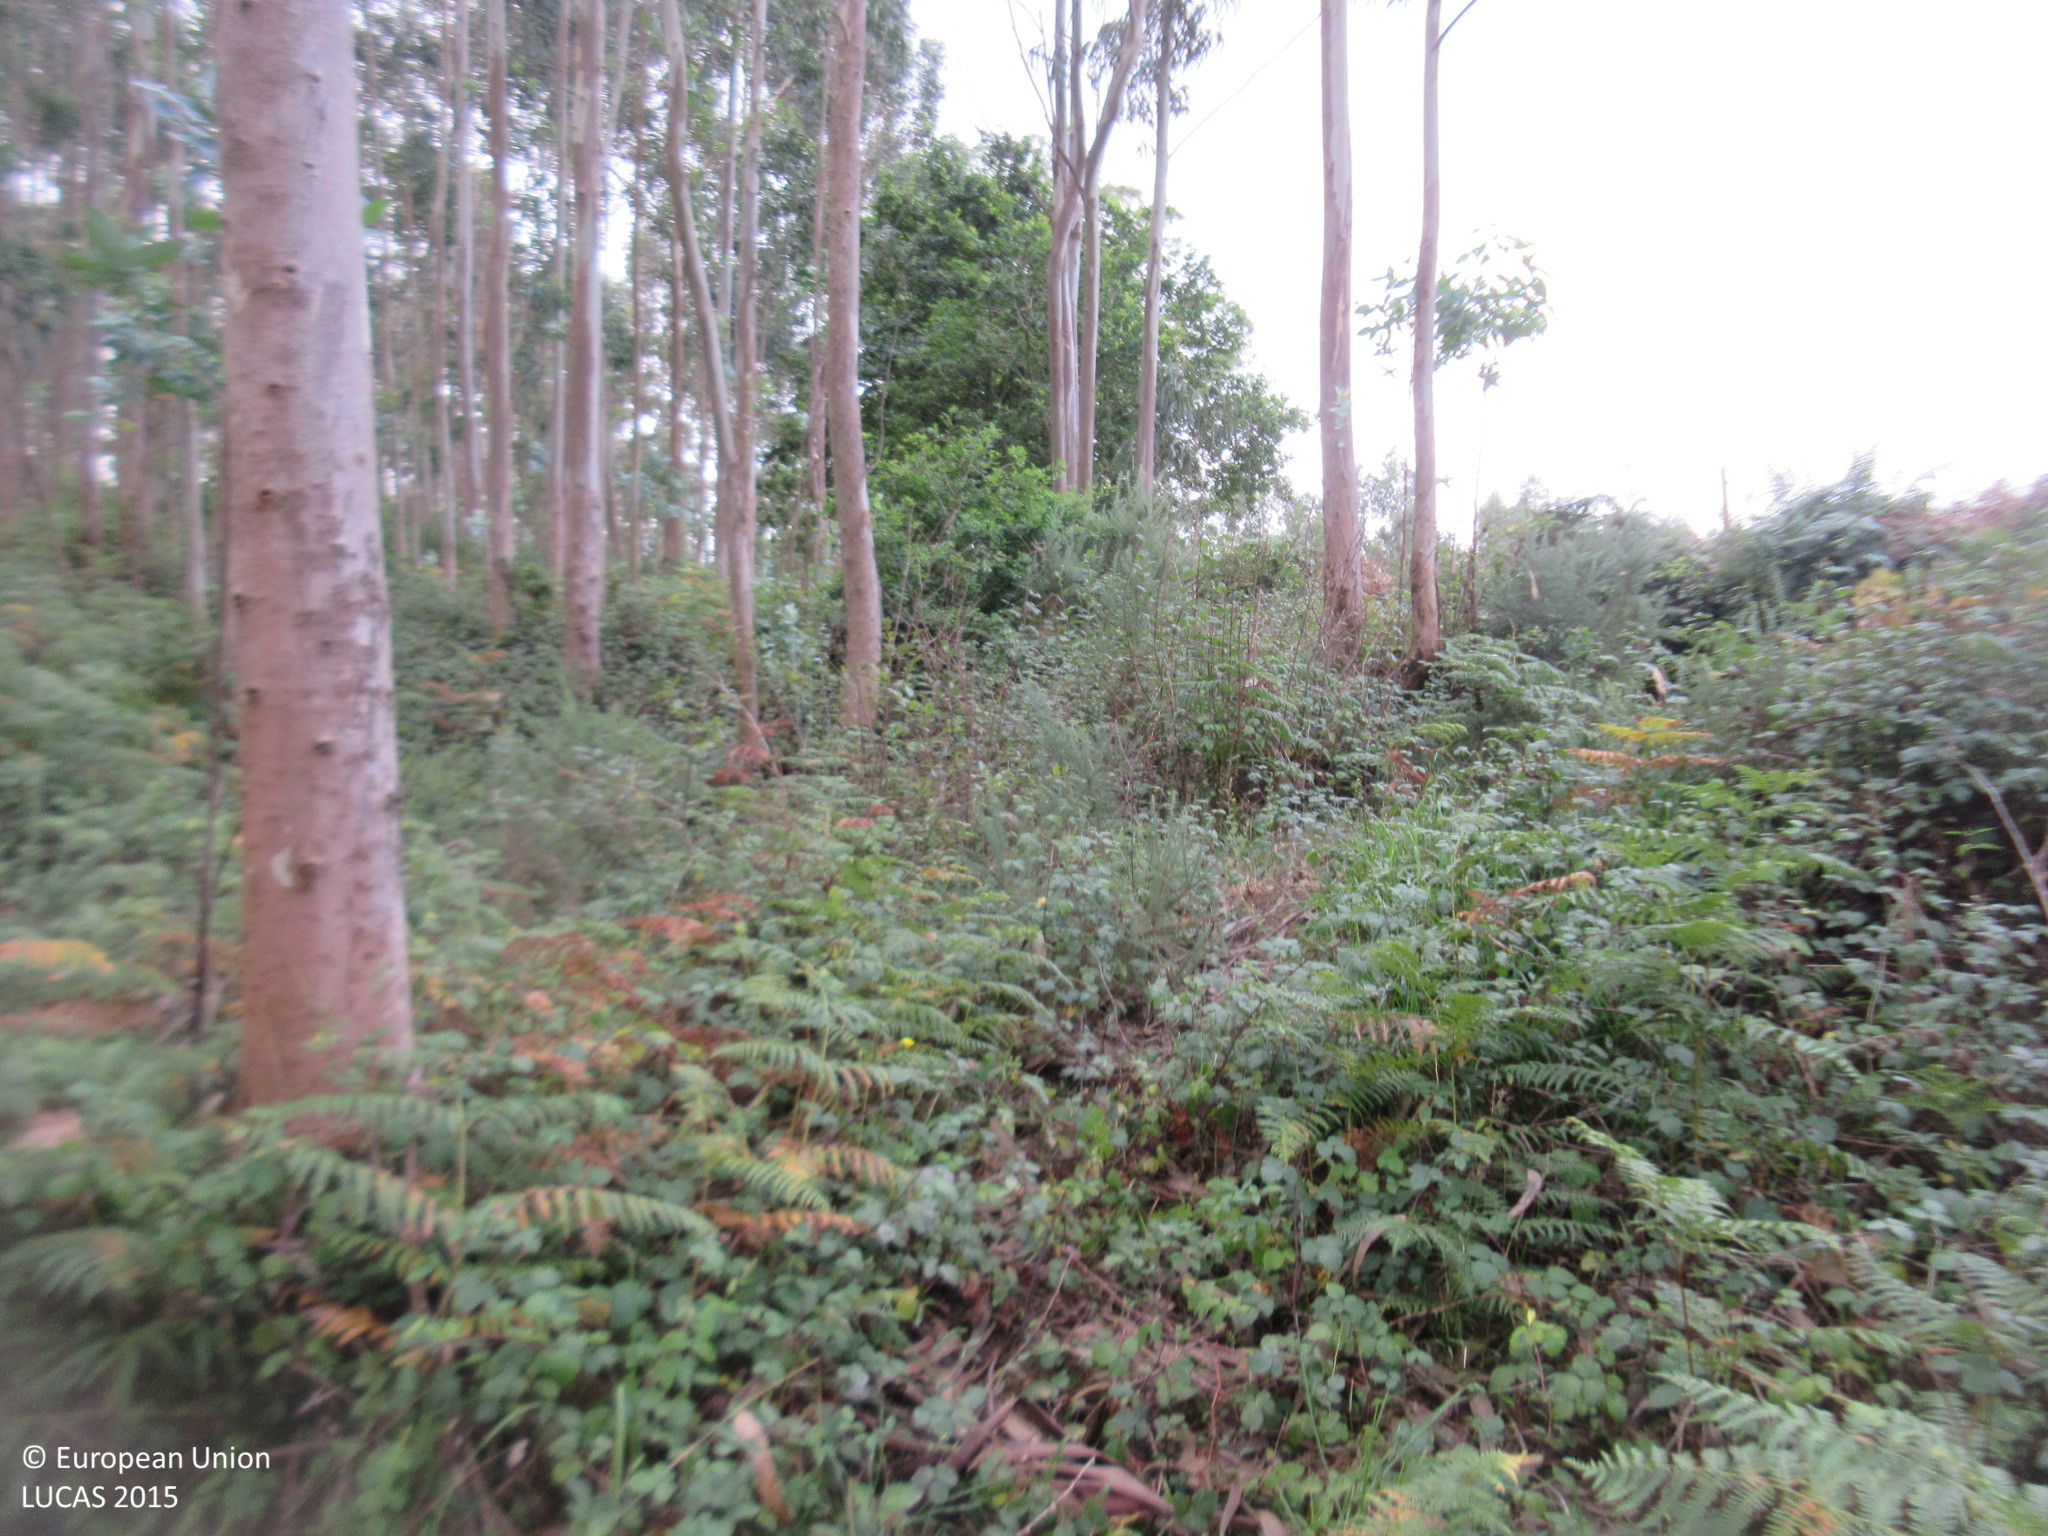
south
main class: Woodland
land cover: Broadleaved woodland
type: exotic forest
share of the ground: > 75 %
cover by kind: broadleaved forest trees 95 %, shrubs 5 %
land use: Forestry
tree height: > 5 m
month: July
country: ES
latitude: 43.3829
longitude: -3.9623
